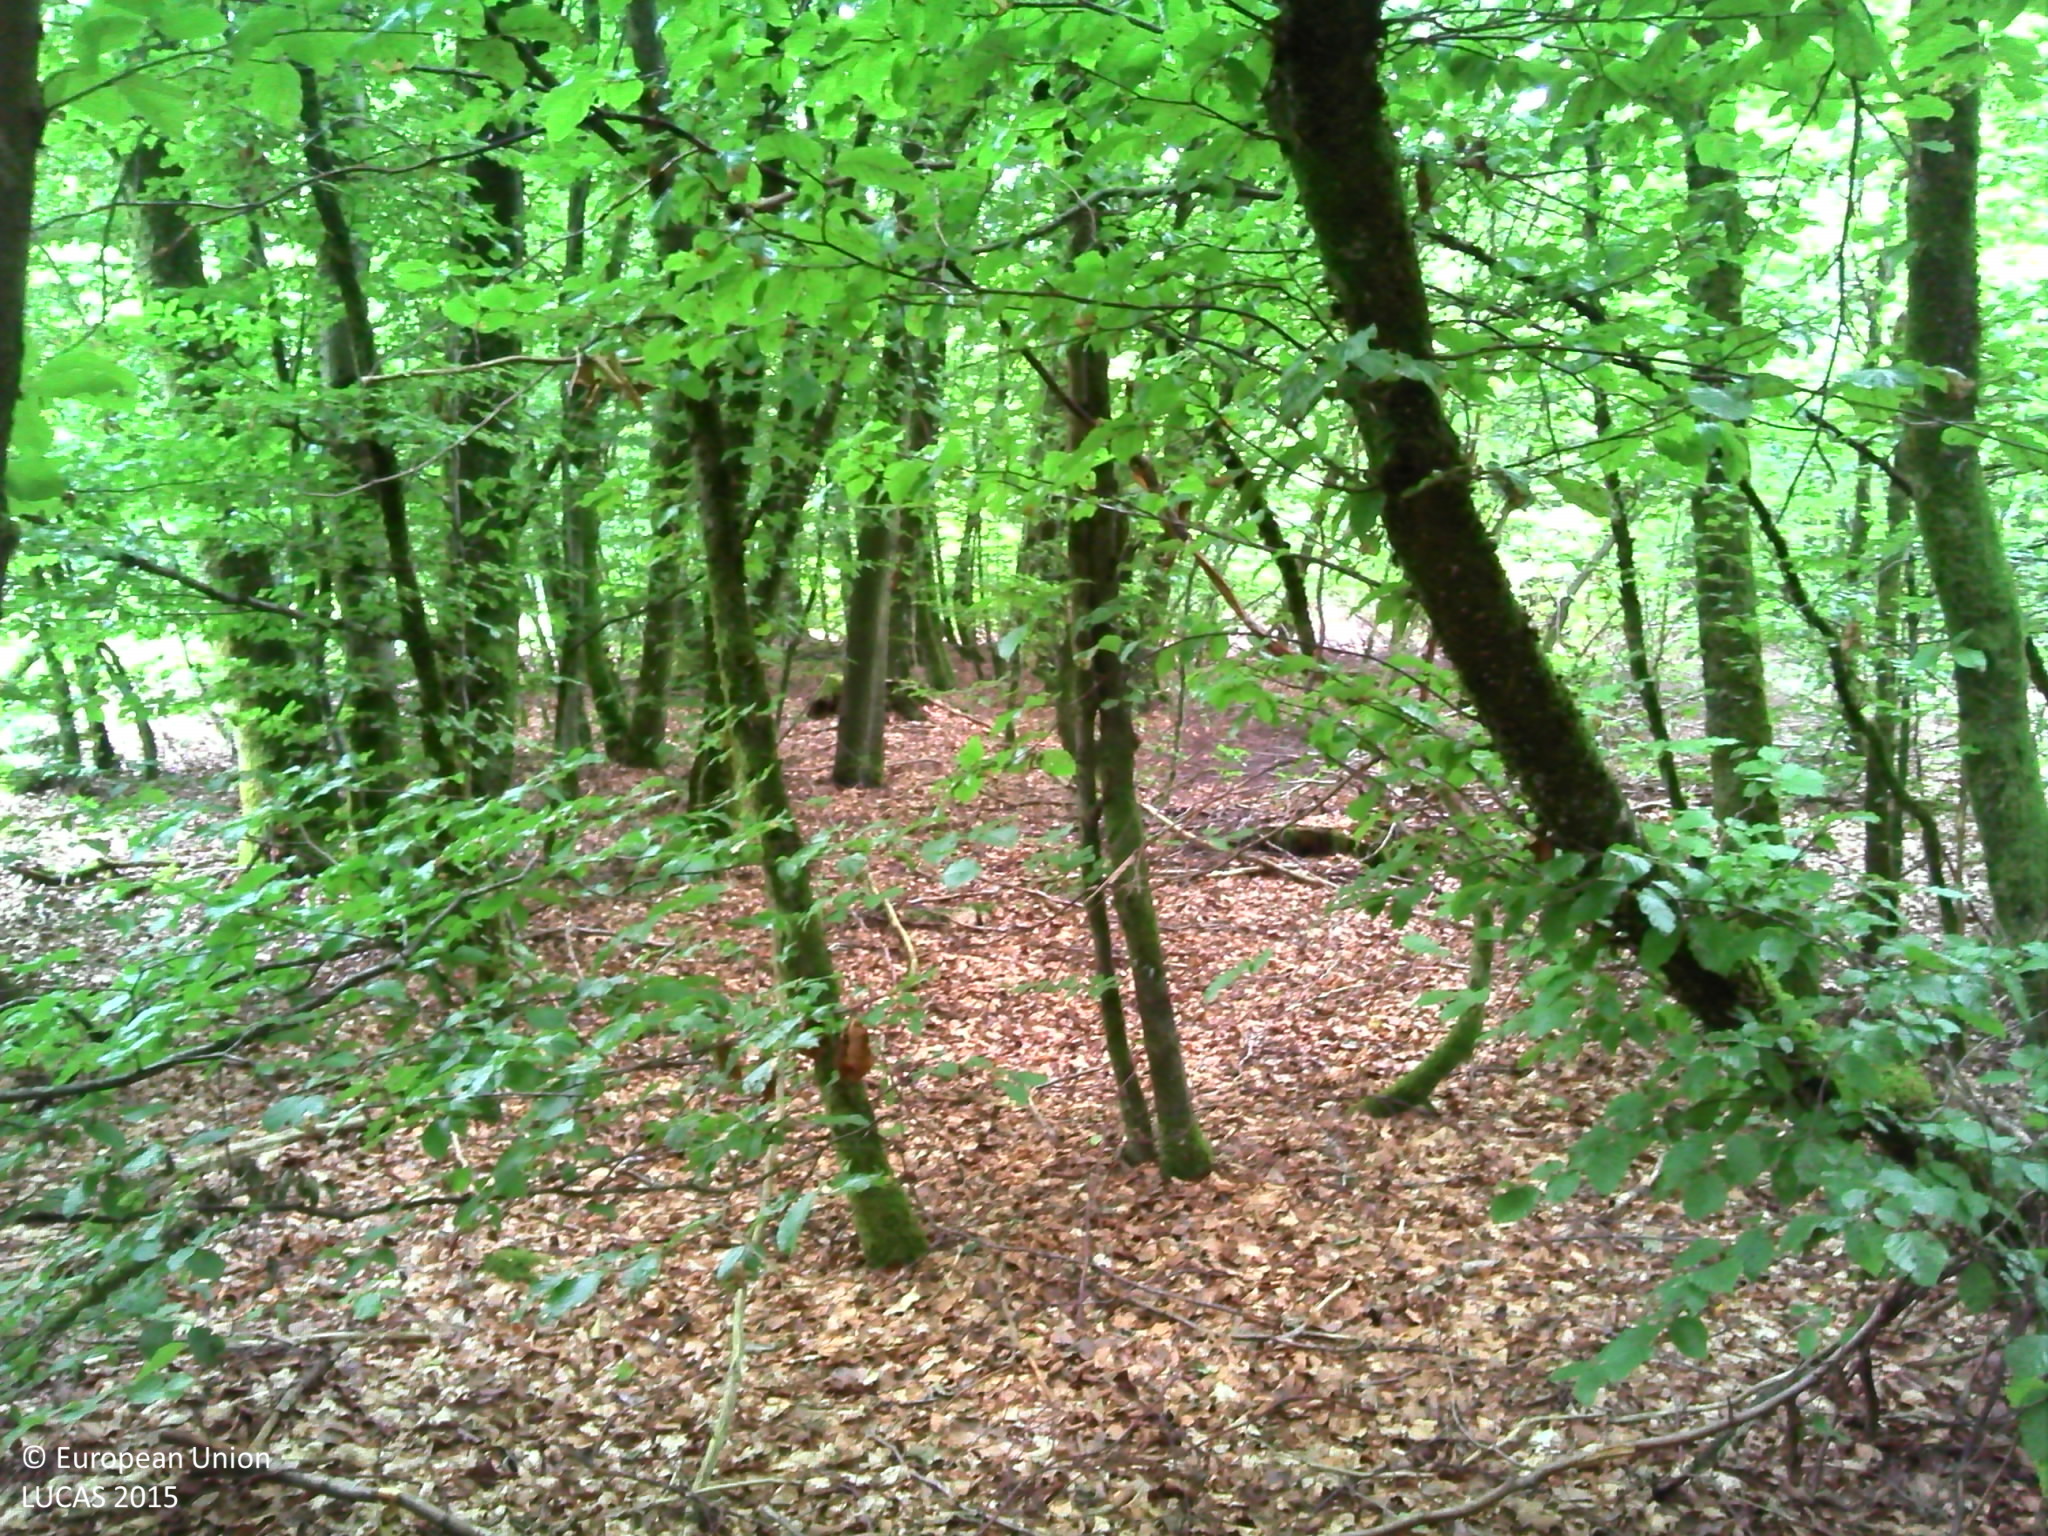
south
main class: Woodland
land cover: Broadleaved woodland
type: beech forest
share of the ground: > 75 %
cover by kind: broadleaved forest trees 100 %
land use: Forestry
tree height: > 5 m
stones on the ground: < 10 %
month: July
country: BE
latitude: 49.7593
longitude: 5.6537
